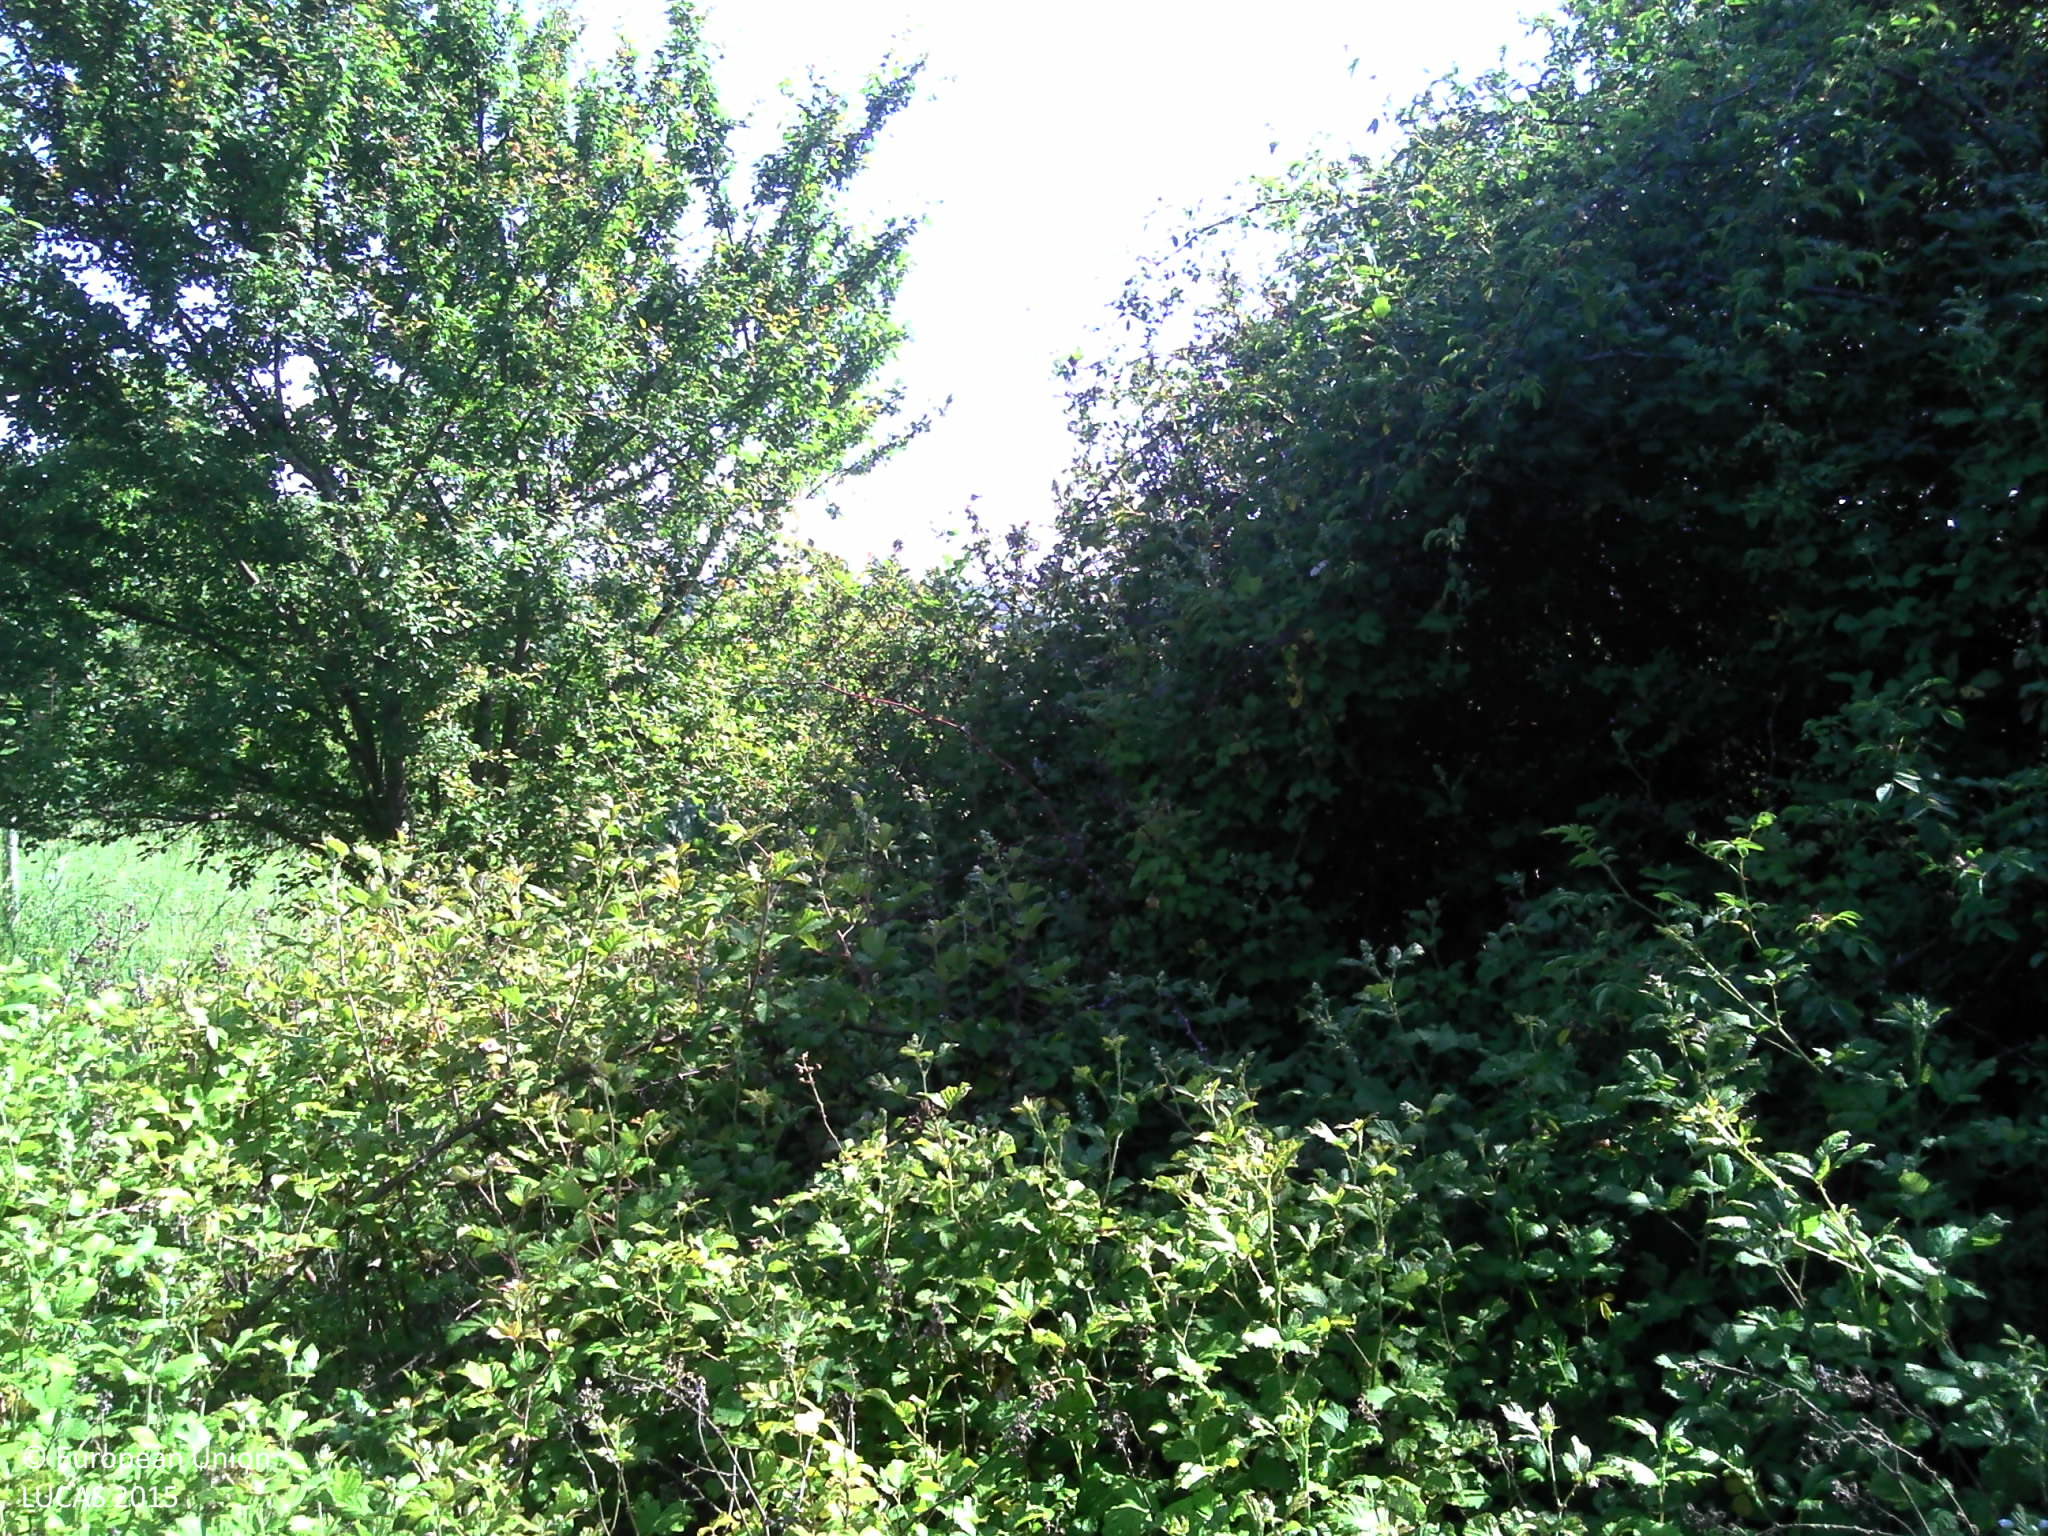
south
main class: Woodland
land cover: Broadleaved woodland
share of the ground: 50 - 75 %
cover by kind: broadleaved forest trees 70 %, herbaceous plants 30 %
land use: Semi-natural and natural areas not in use
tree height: < 5 m
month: June
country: FR
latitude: 47.5522
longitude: 3.9513
